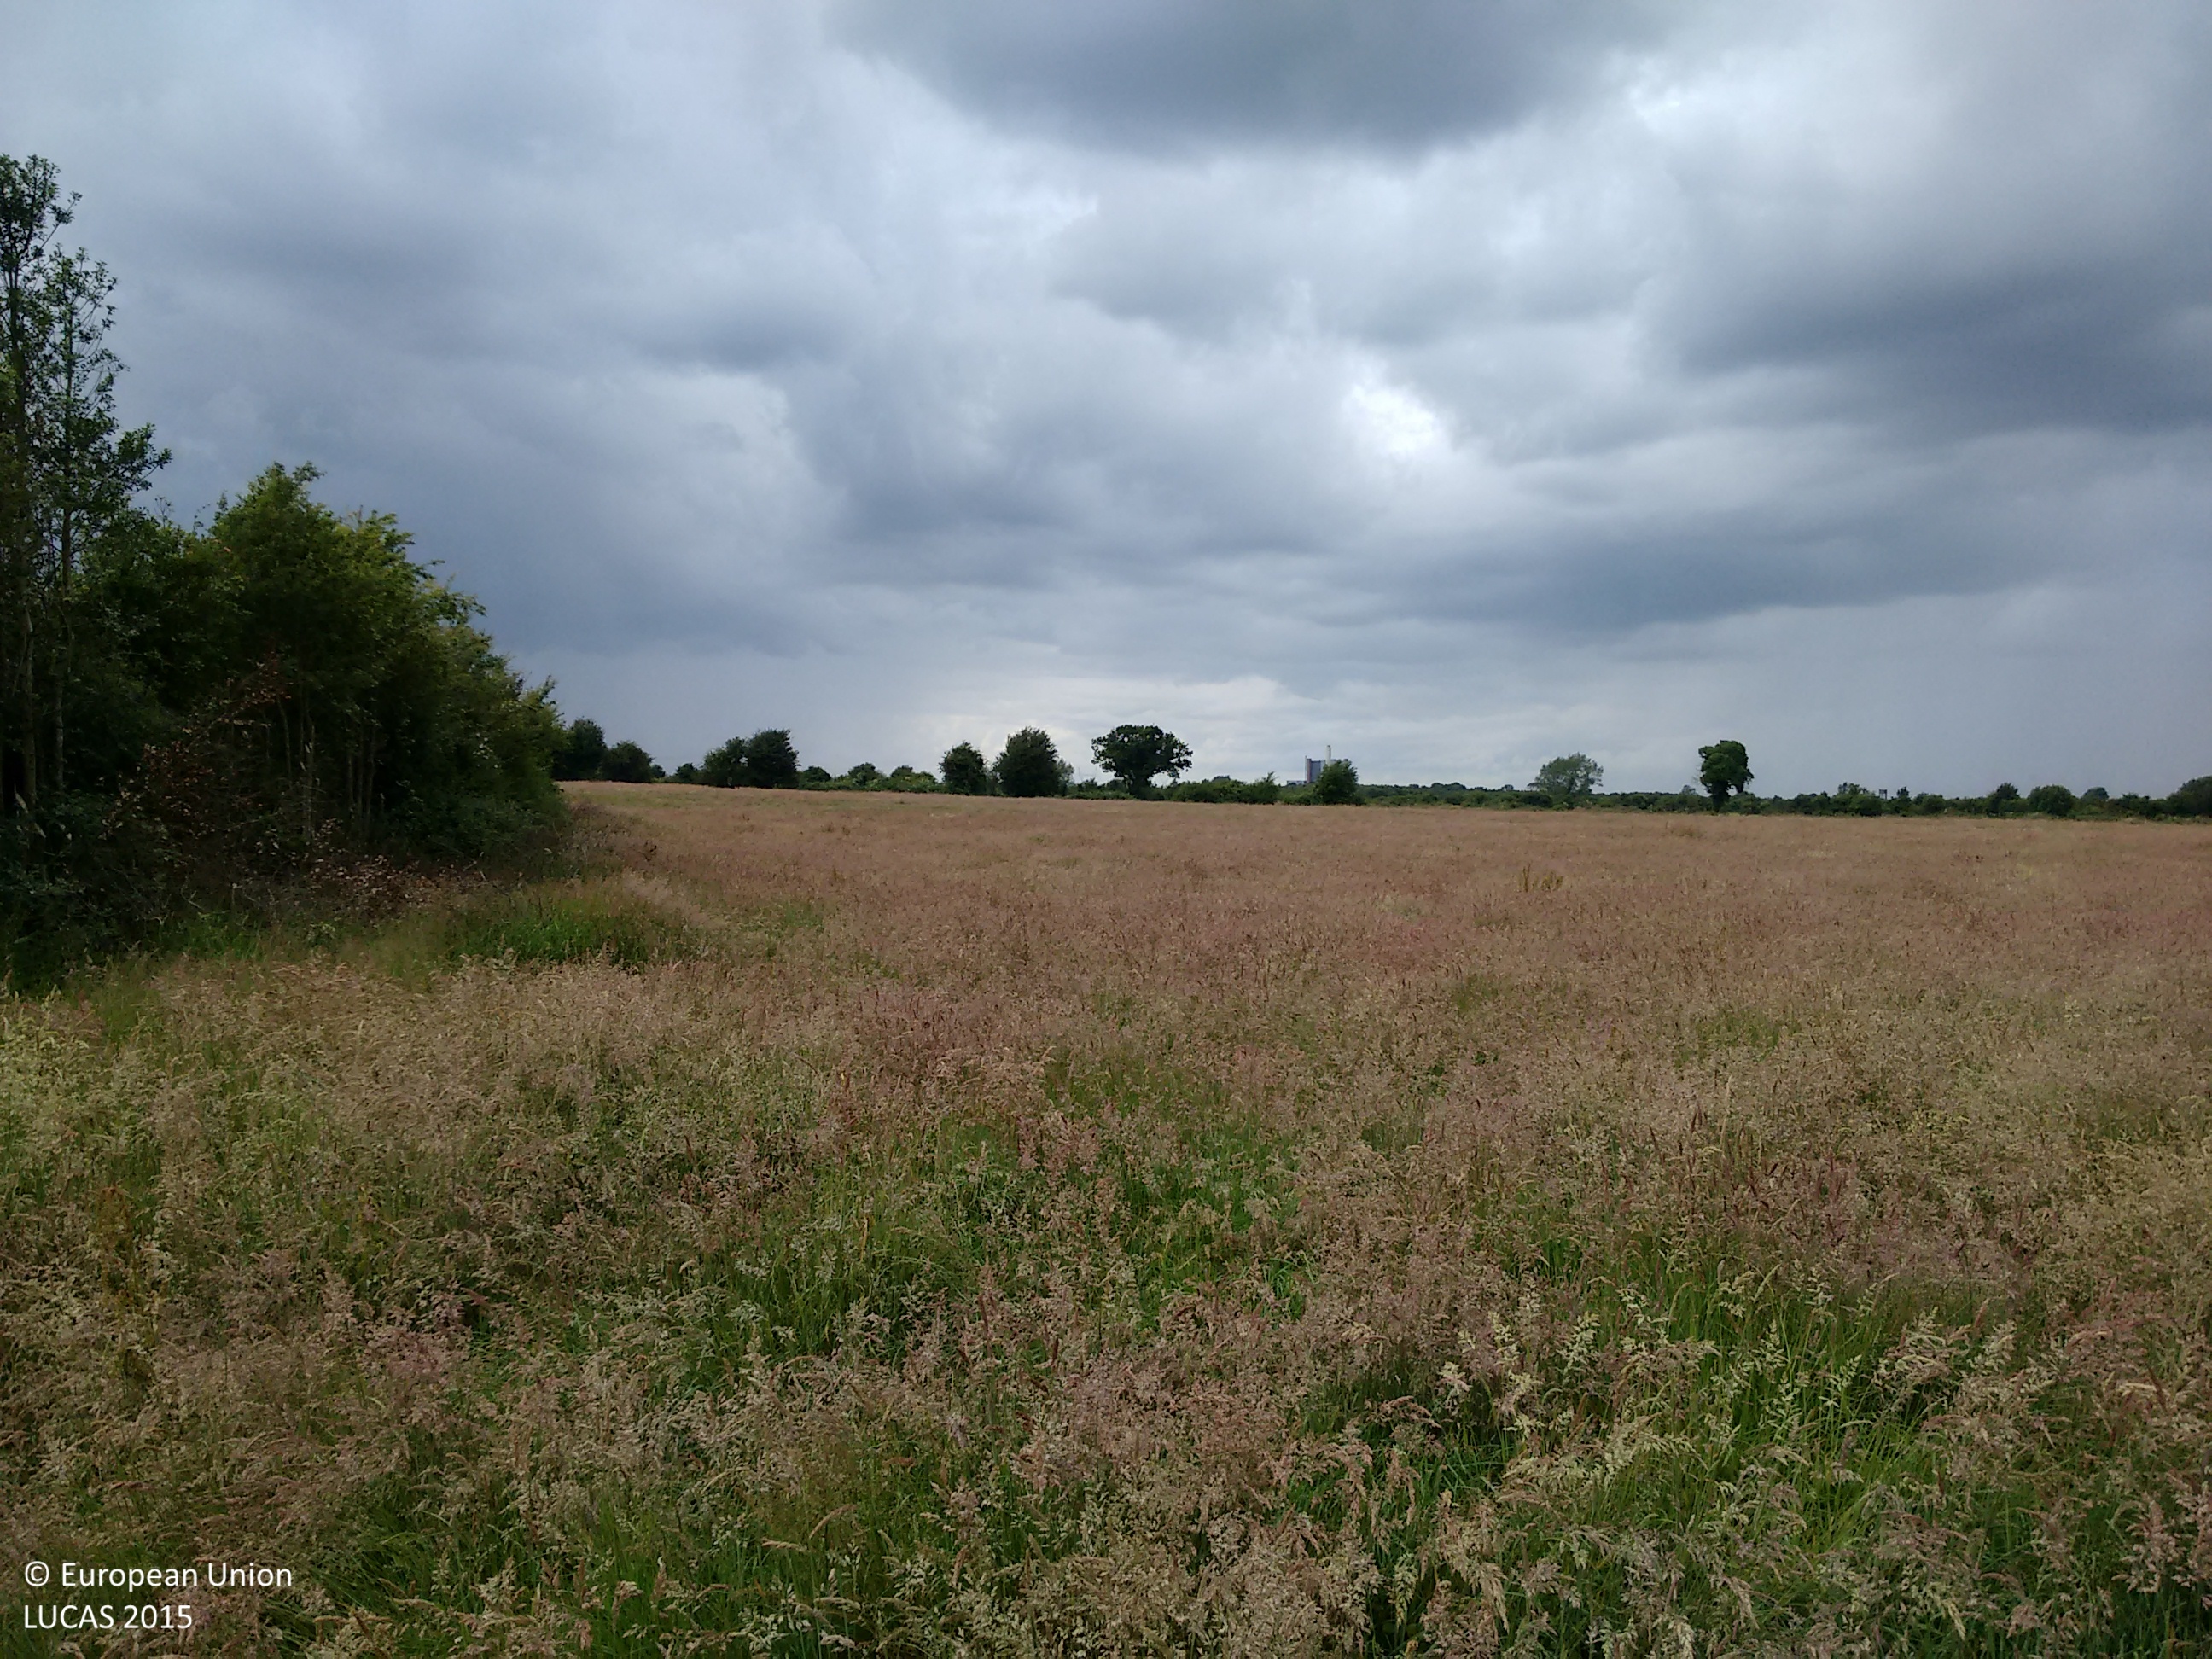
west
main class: Grassland
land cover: Spontaneously vegetated surfaces
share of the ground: > 75 %
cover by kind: herbaceous plants 100 %
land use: Fallow land
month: July
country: IE
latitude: 53.2720
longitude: -8.0047
